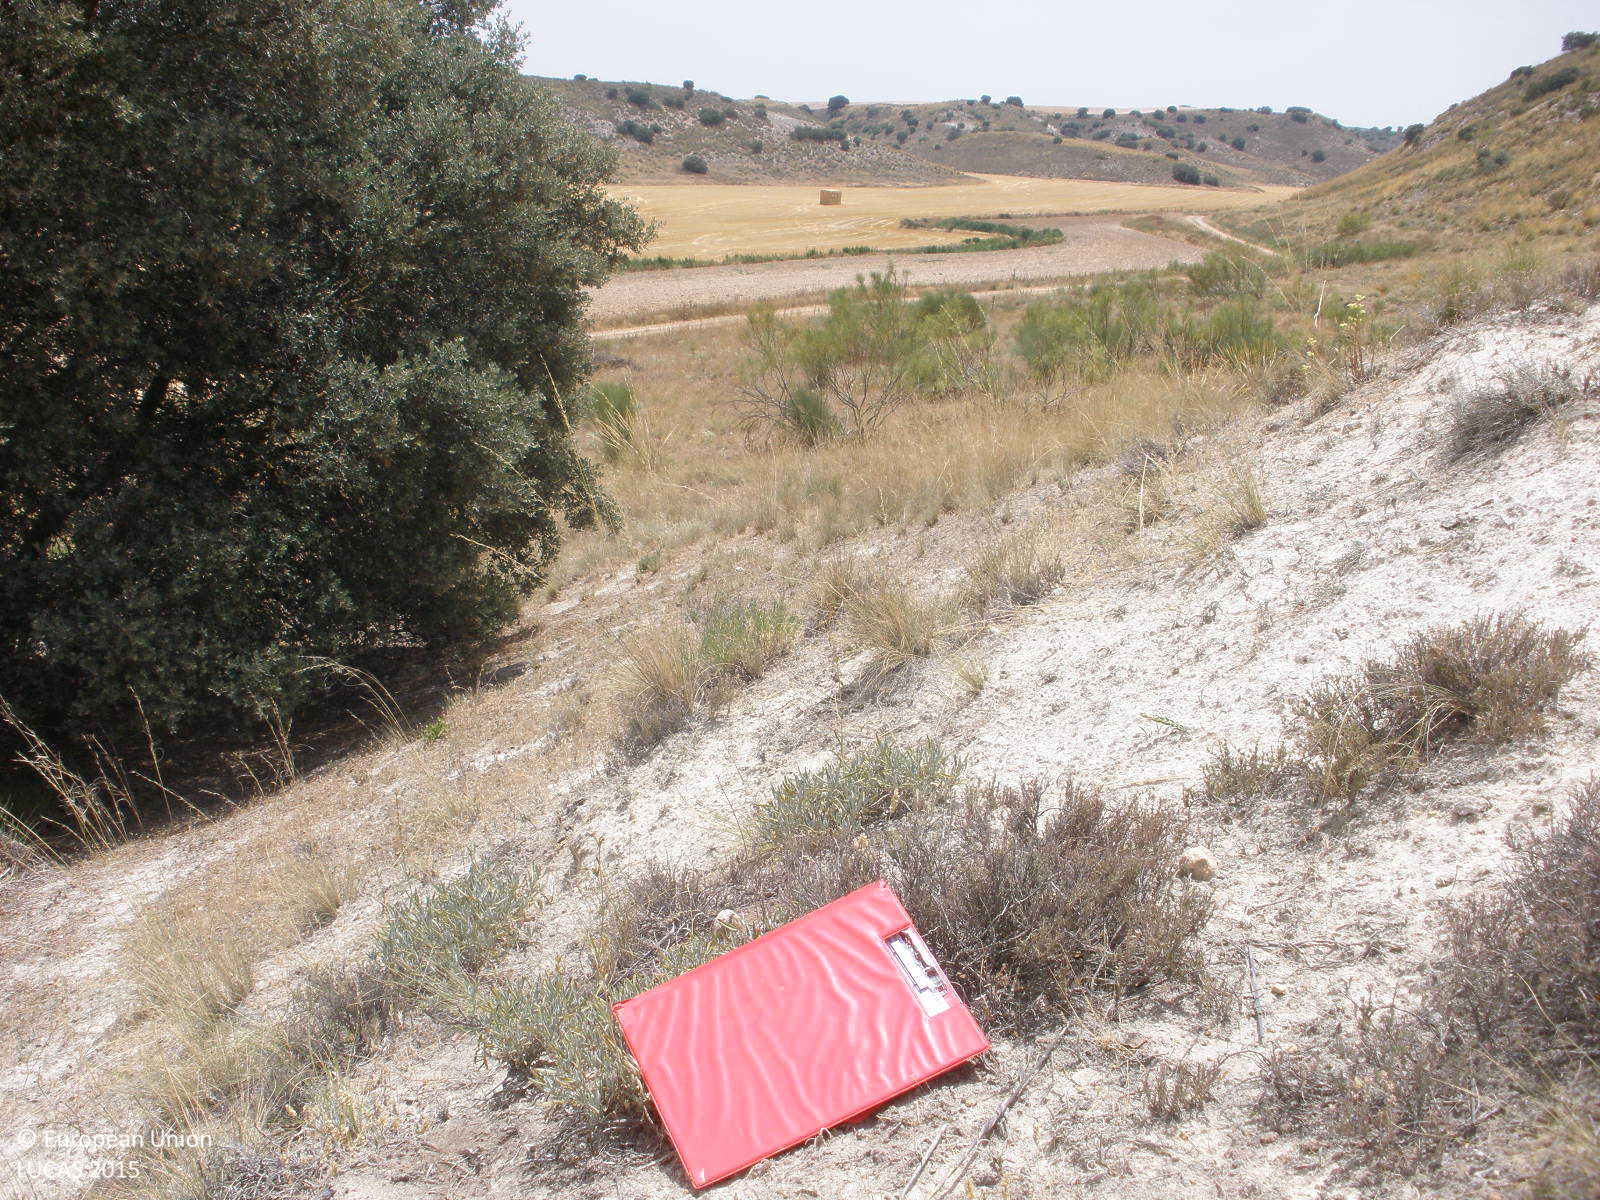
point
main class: Grassland
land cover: Grassland with sparse tree/shrub cover
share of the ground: 50 - 75 %
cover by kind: herbaceous plants 65 %, consolidated bare surface 25 %, broadleaved forest trees 5 %, shrubs 5 %
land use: Semi-natural and natural areas not in use
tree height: < 5 m
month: July
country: ES
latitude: 39.8613
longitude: -3.3639
